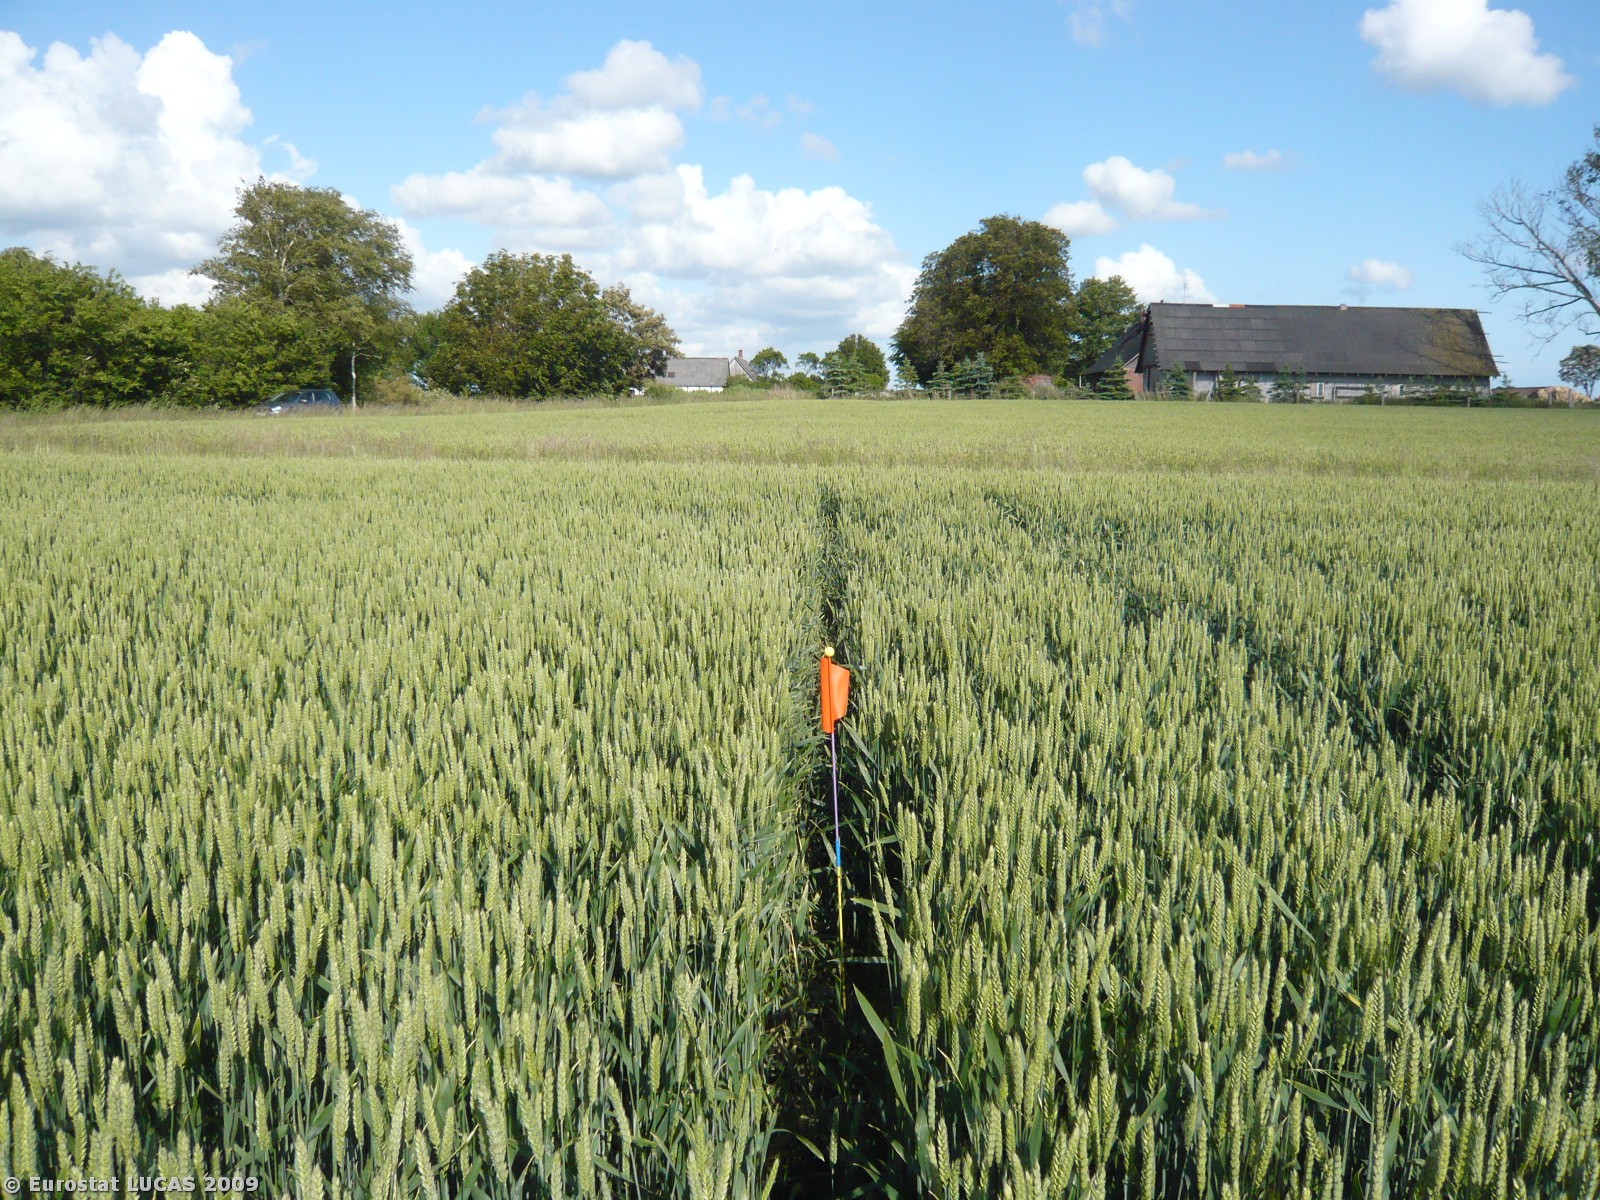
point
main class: Cropland
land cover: Common wheat
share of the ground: > 75 %
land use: Agriculture (excluding fallow land and kitchen gardens)
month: June
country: DK
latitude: 54.7044
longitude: 11.5354
